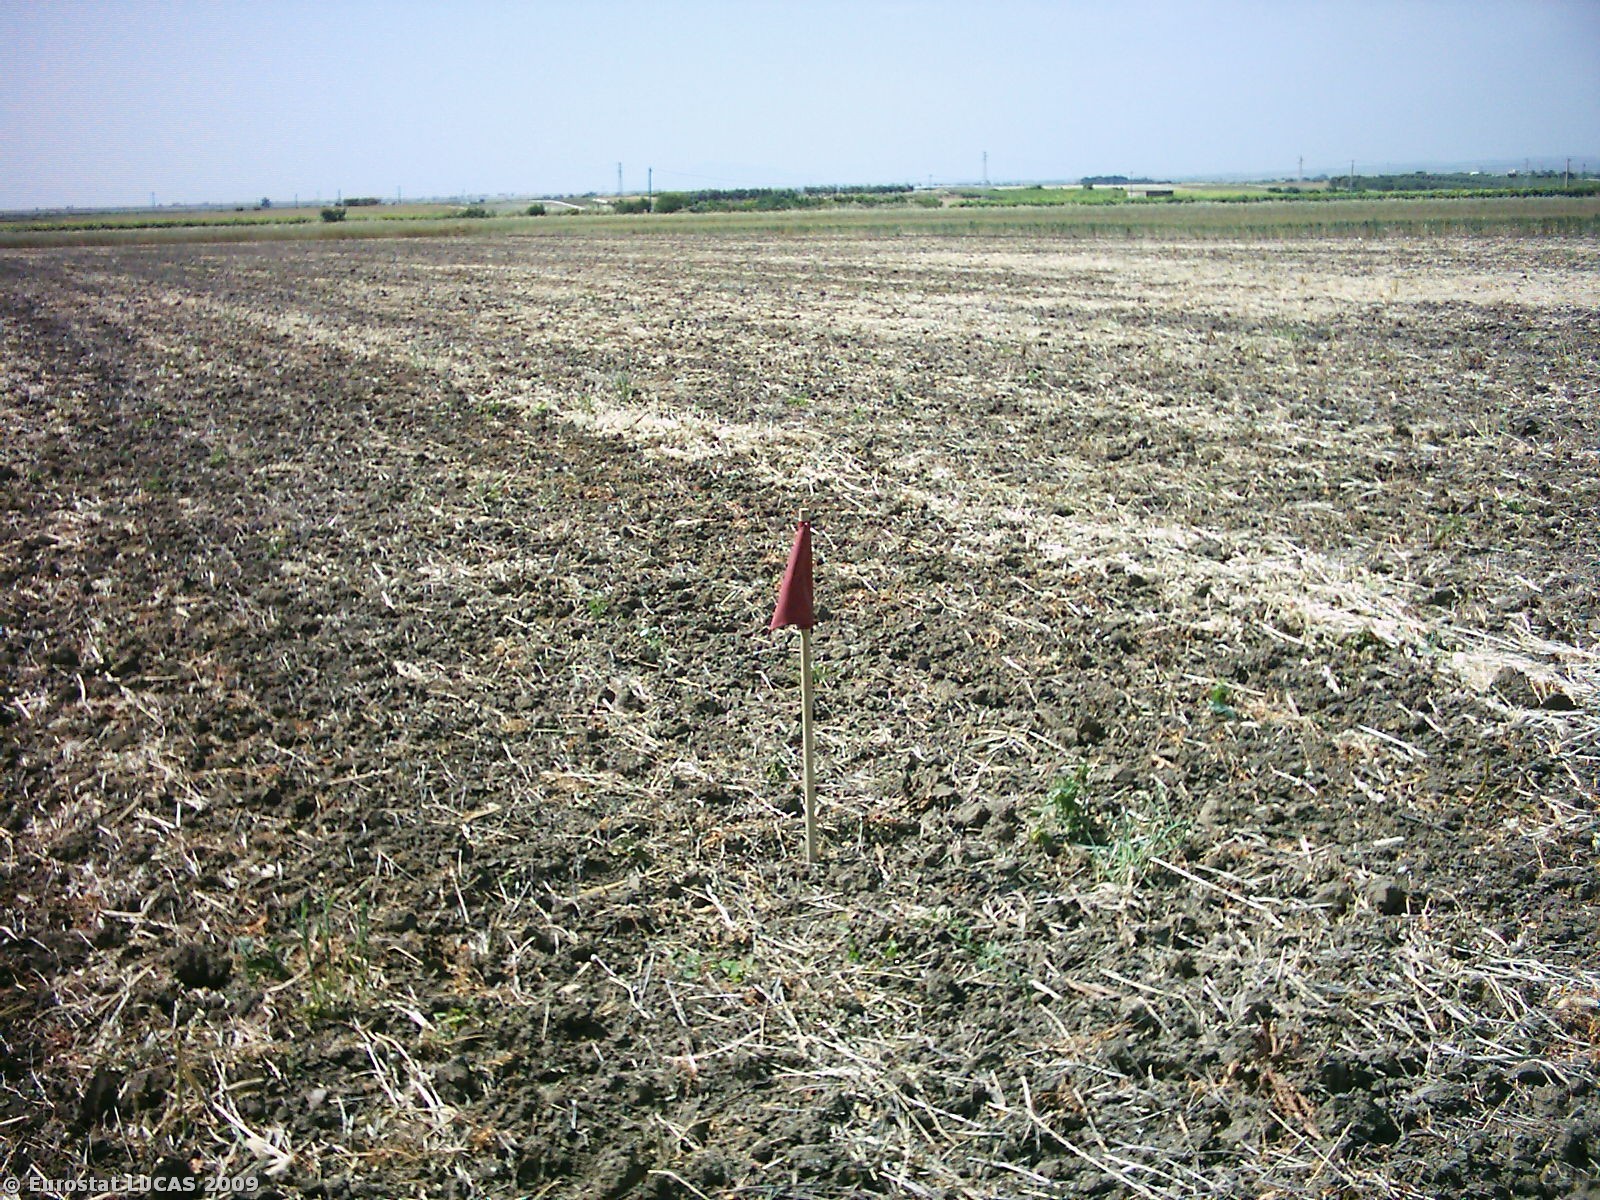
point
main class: Cropland
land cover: Temporary grasslands
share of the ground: < 10 %
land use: Agriculture (excluding fallow land and kitchen gardens)
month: May
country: IT
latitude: 41.3369
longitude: 15.6572
